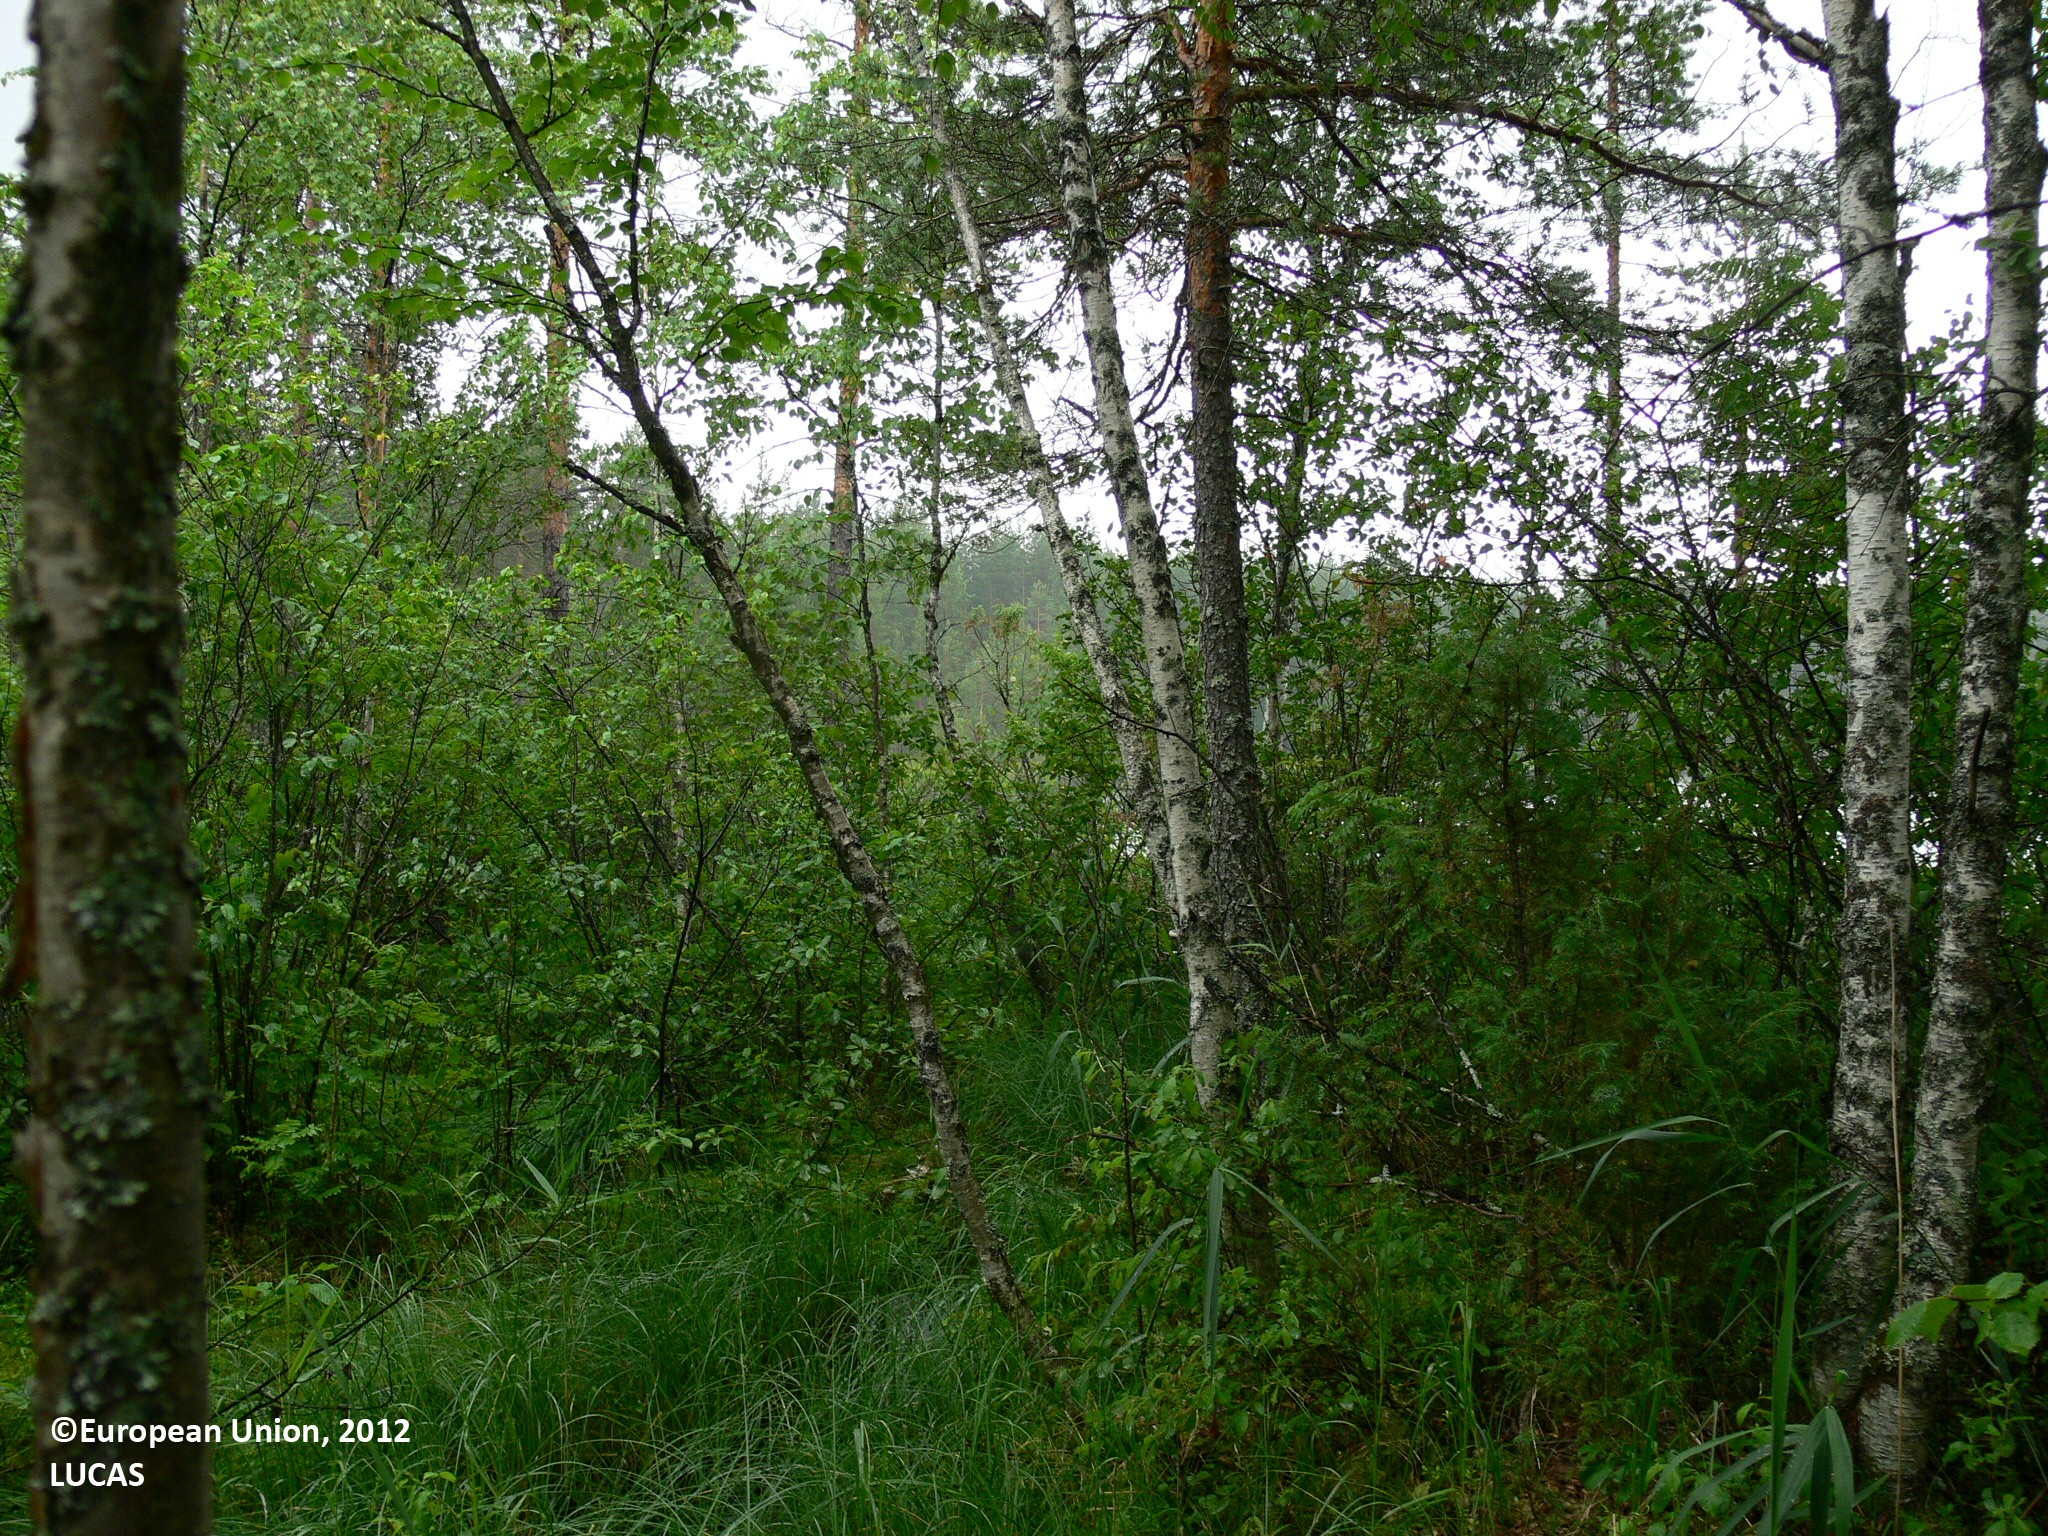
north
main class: Woodland
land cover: Pine dominated mixed woodland
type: boreal forest
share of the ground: > 75 %
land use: Semi-natural and natural areas not in use
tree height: > 5 m
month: July
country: FI
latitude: 63.1052
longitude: 30.7971
